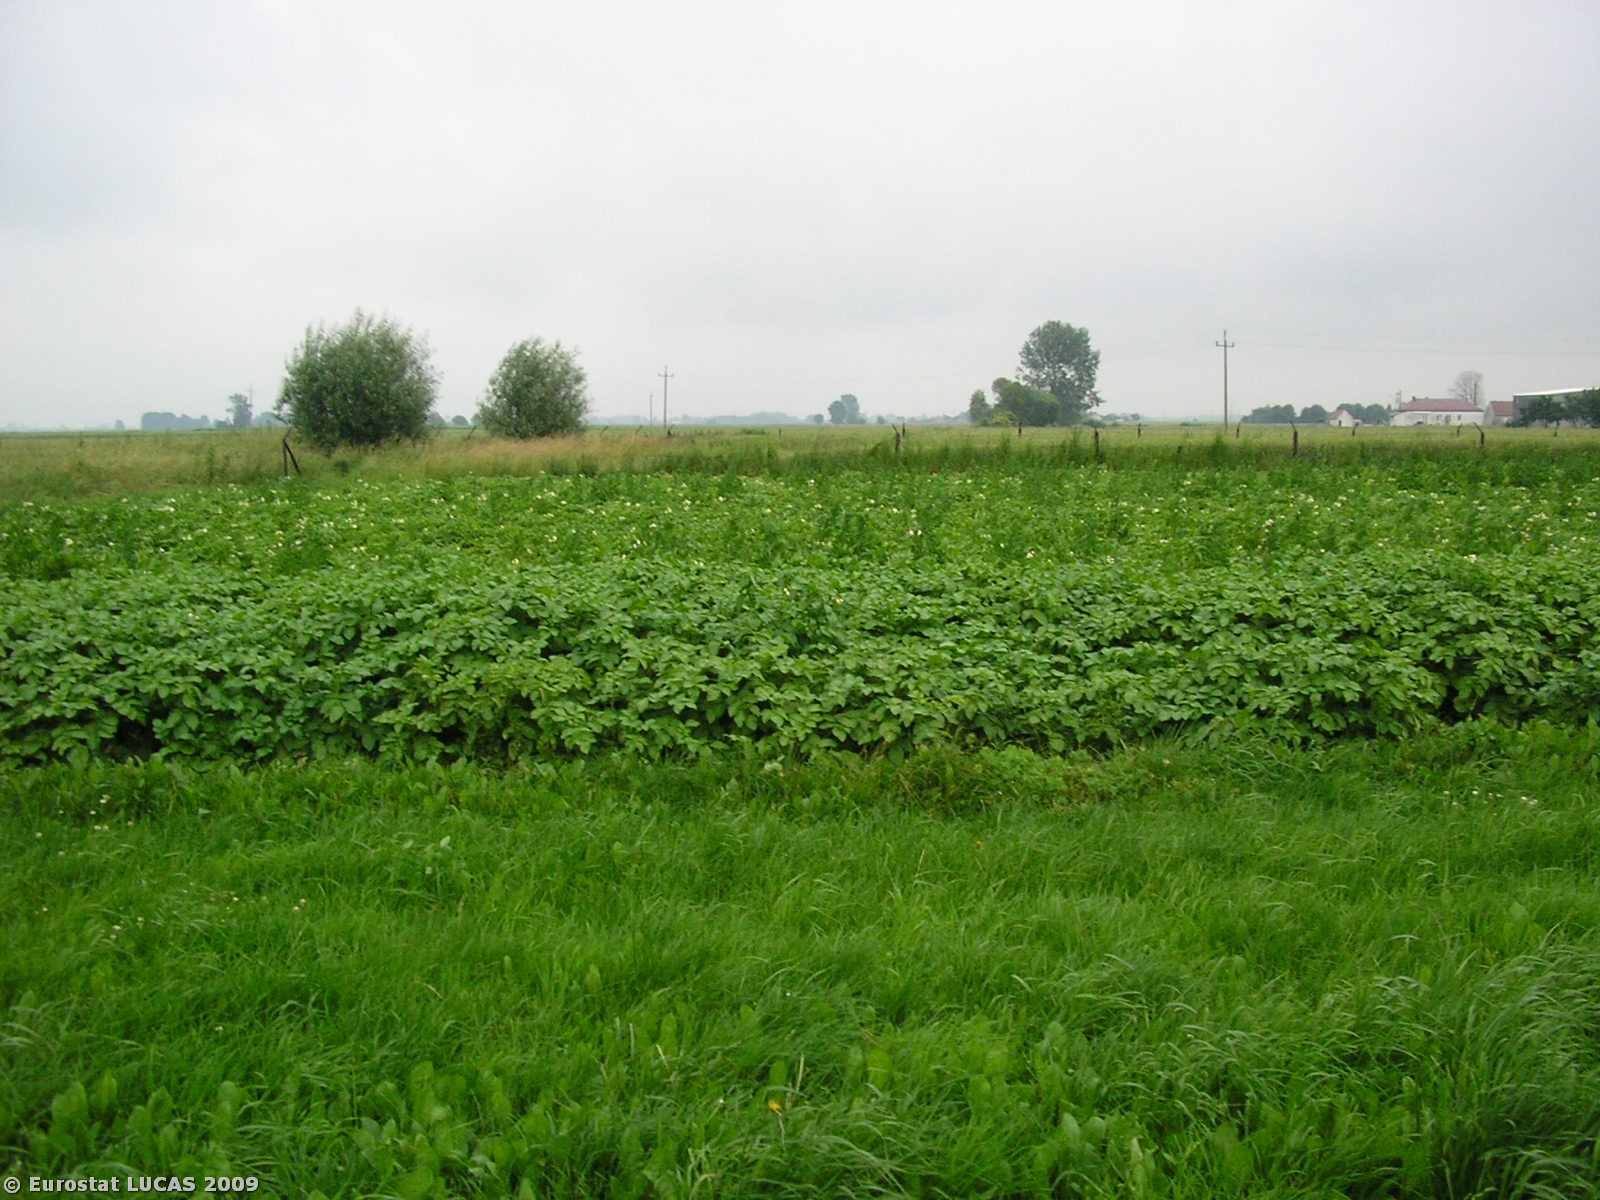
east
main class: Grassland
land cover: Grassland without tree/shrub cover
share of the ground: > 75 %
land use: Agriculture (excluding fallow land and kitchen gardens)
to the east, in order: Grassland without tree/shrub cover; Potatoes; Barley; Fences; Common wheat; Artificial constructions in urban areas; Fences; Ditches and canals; Grass margins; Common wheat; Potatoes; Common wheat; Potatoes; Grass margins; Potatoes; Common wheat; Grass margins; Common wheat; Electric lines; Common wheat; Grass margins; Ditches and canals; Potatoes
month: June
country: PL
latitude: 51.2458
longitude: 18.4281
